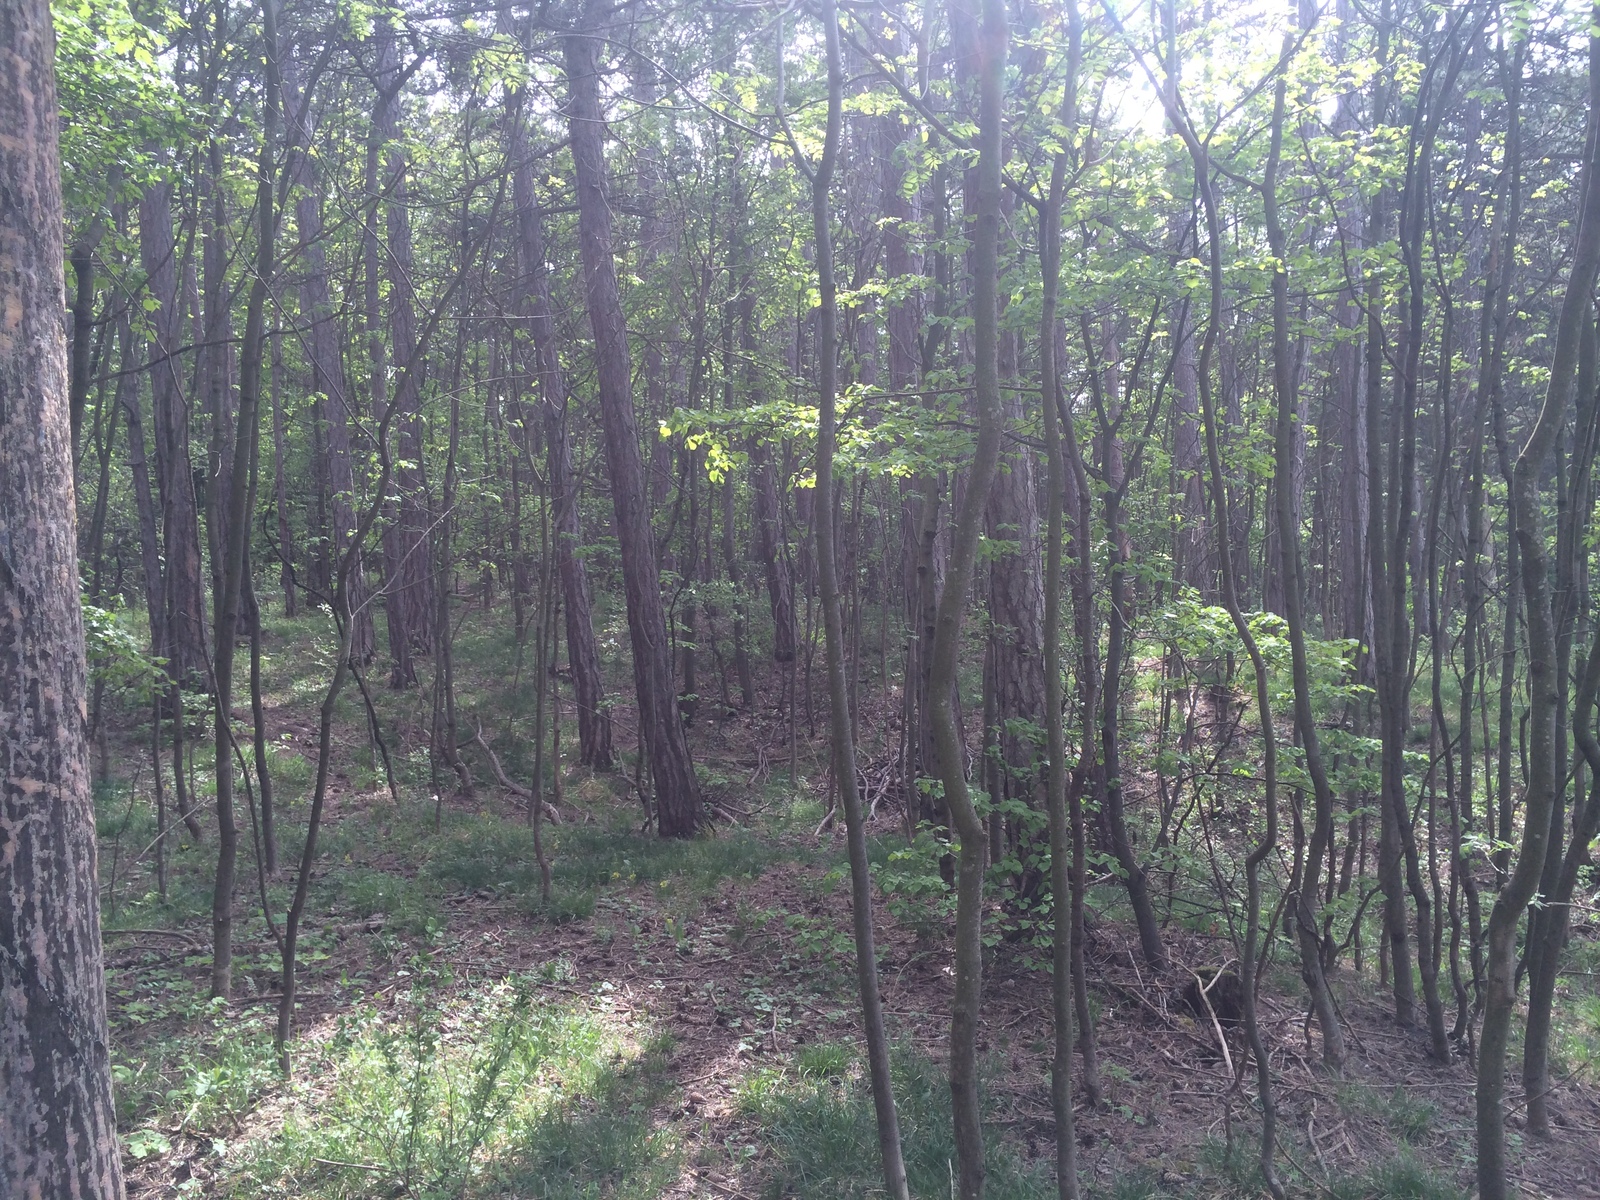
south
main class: Woodland
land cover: Pine dominated mixed woodland
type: hemiboreal forest and nemoral coniferous forest and mixed broadleaved-coniferous forest
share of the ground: > 75 %
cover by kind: coniferous forest trees 65 %, broadleaved forest trees 25 %, herbaceous plants 10 %
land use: Forestry
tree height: > 5 m
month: May
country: AT
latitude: 47.8913
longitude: 16.1156
